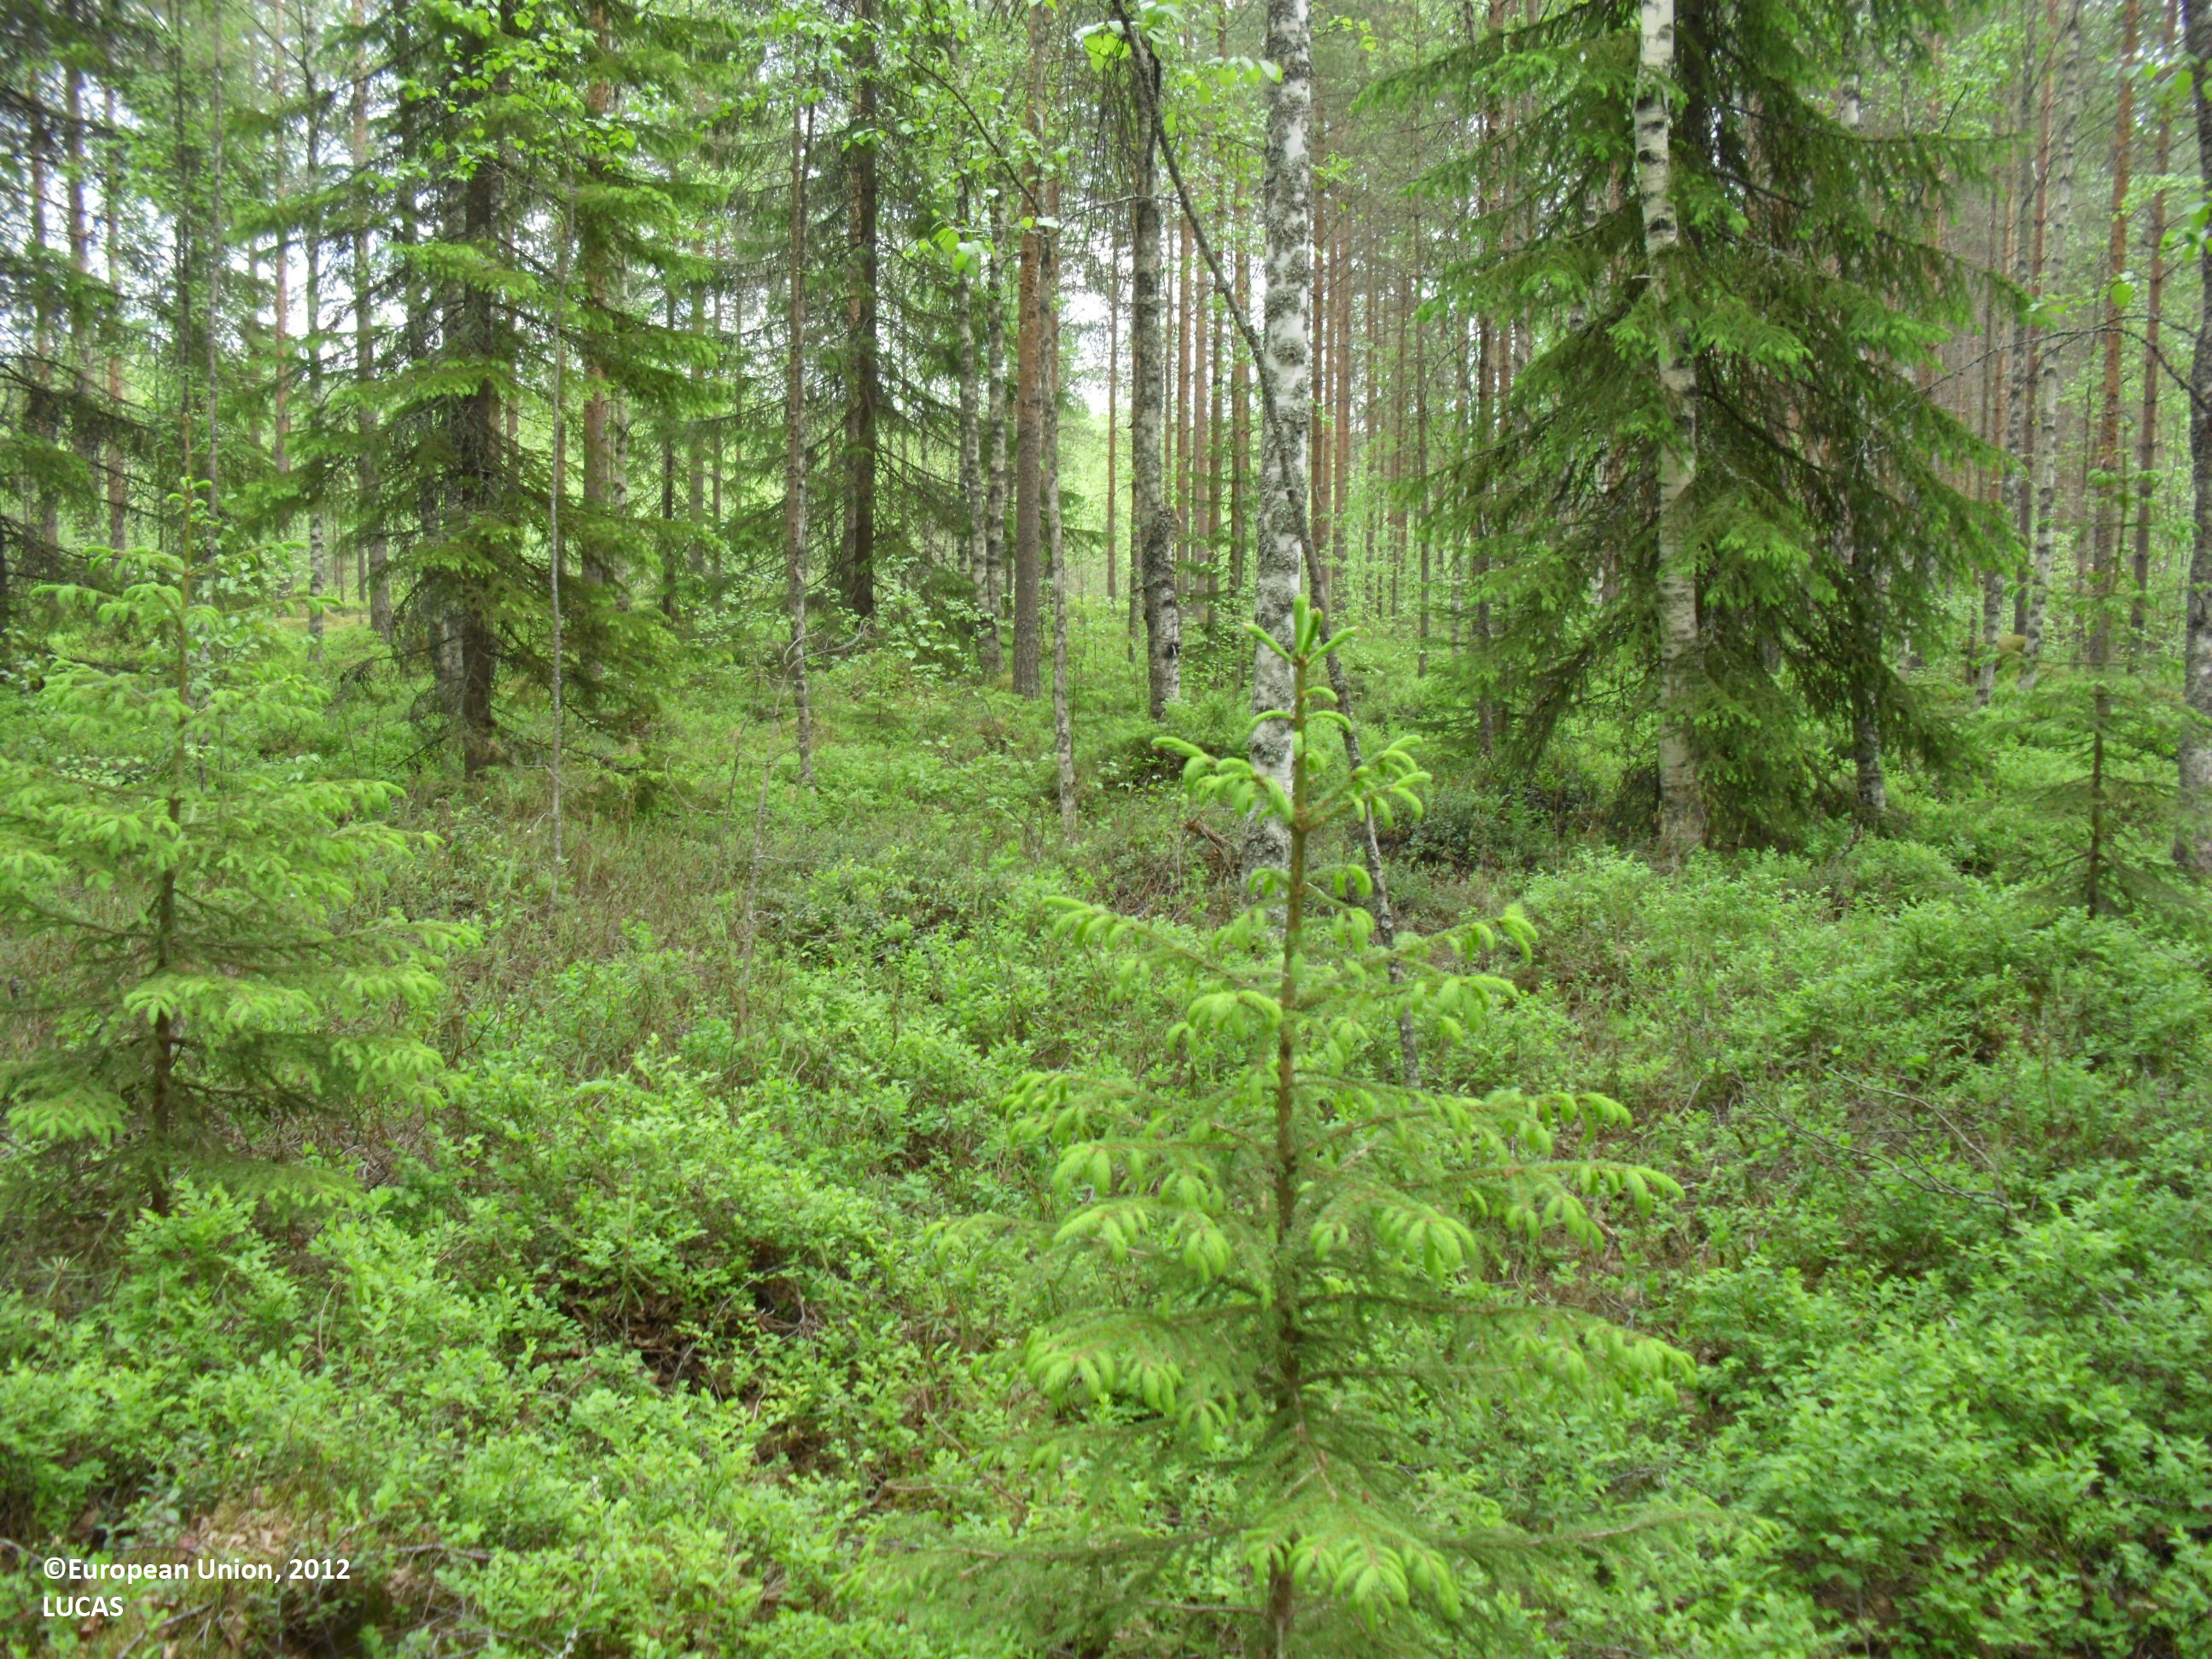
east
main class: Woodland
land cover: Other mixed woodland
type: boreal forest
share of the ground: 50 - 75 %
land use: Forestry
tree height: > 5 m
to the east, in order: Other mixed woodland; Pine dominated mixed woodland; Tracks; Other mixed woodland; Spontaneously vegetated surfaces; Other mixed woodland; Spontaneously vegetated surfaces; Other mixed woodland; Ditches and canals; Pine dominated coniferous woodland; Ditches and canals; Pine dominated coniferous woodland; Other mixed woodland
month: June
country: FI
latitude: 63.2412
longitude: 23.5833
